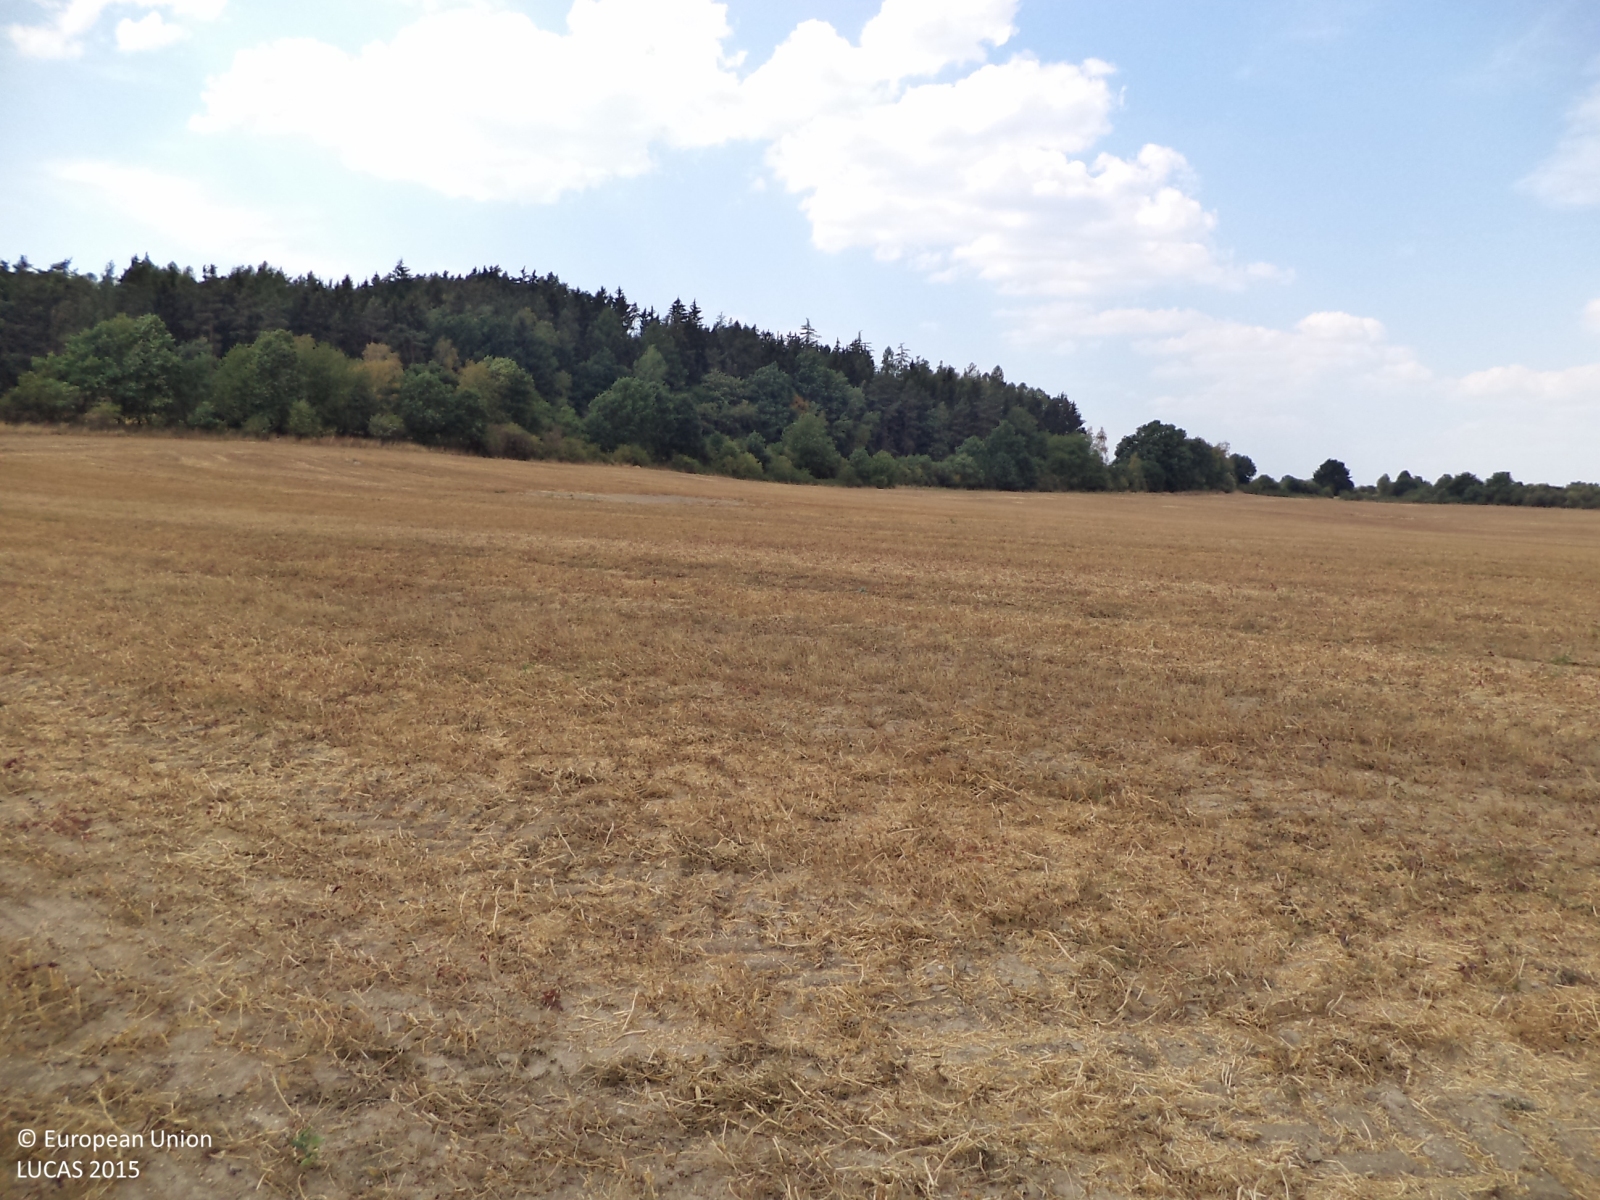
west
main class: Cropland
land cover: Dry pulses
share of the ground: 25 - 50 %
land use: Agriculture (excluding fallow land and kitchen gardens)
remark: Harvested field
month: August
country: CZ
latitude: 49.6967
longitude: 14.5629
